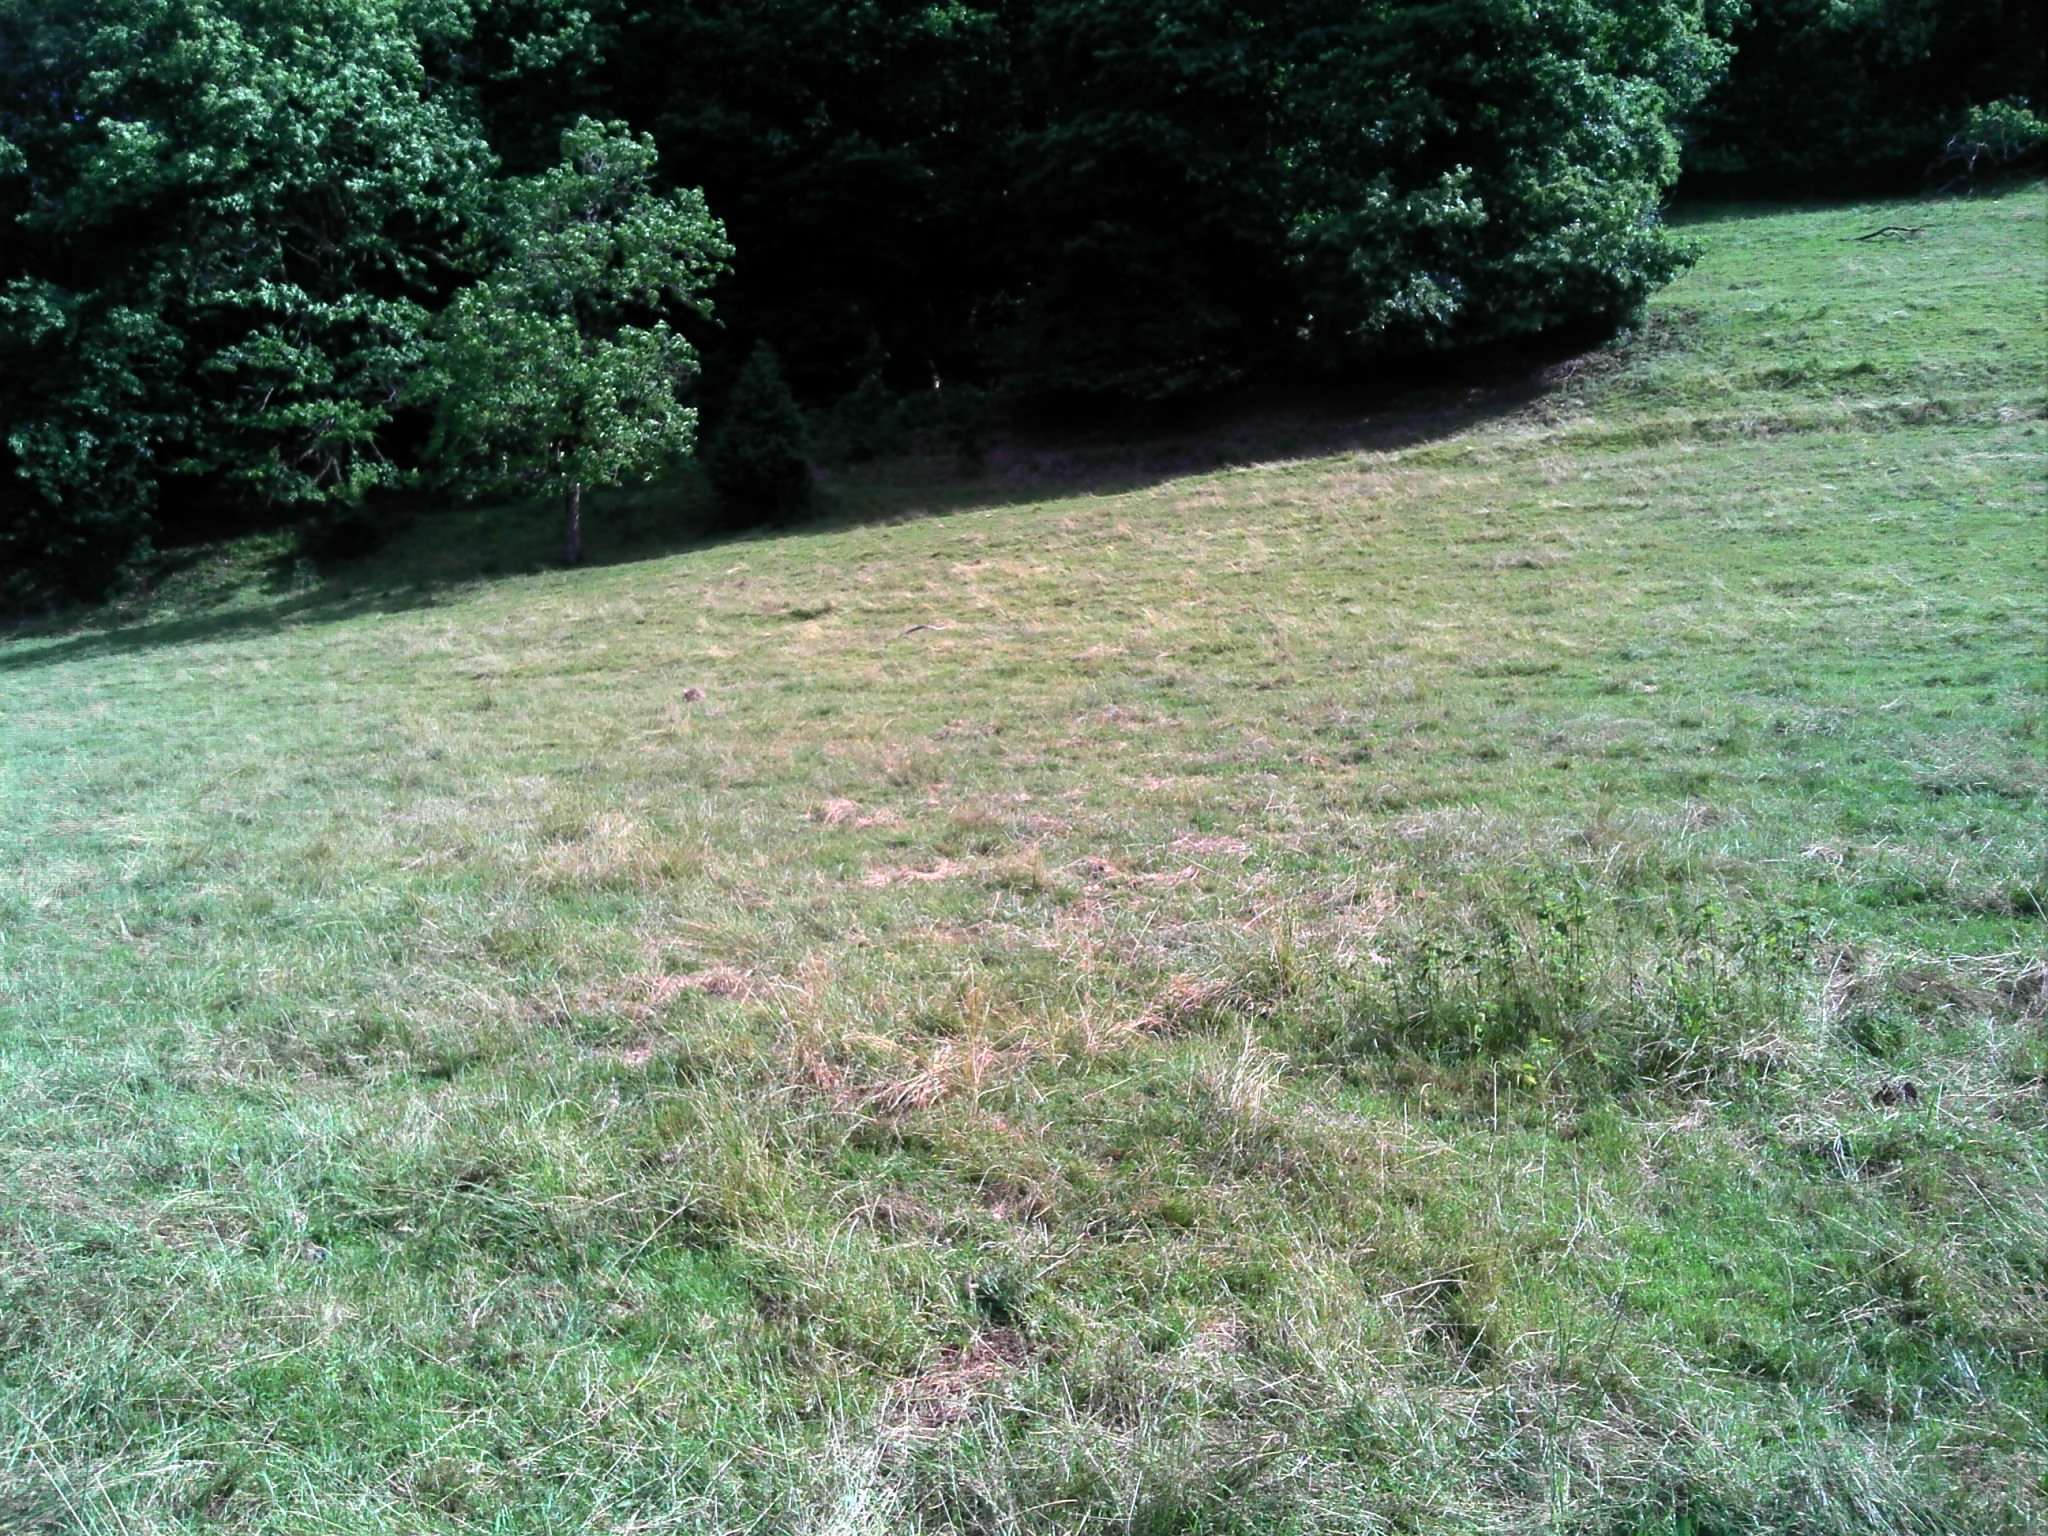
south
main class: Grassland
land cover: Grassland with sparse tree/shrub cover
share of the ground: > 75 %
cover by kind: herbaceous plants 95 %, broadleaved forest trees 5 %
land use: Agriculture (excluding fallow land and kitchen gardens)
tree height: > 5 m
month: June
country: FR
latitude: 44.8895
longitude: 1.9585
